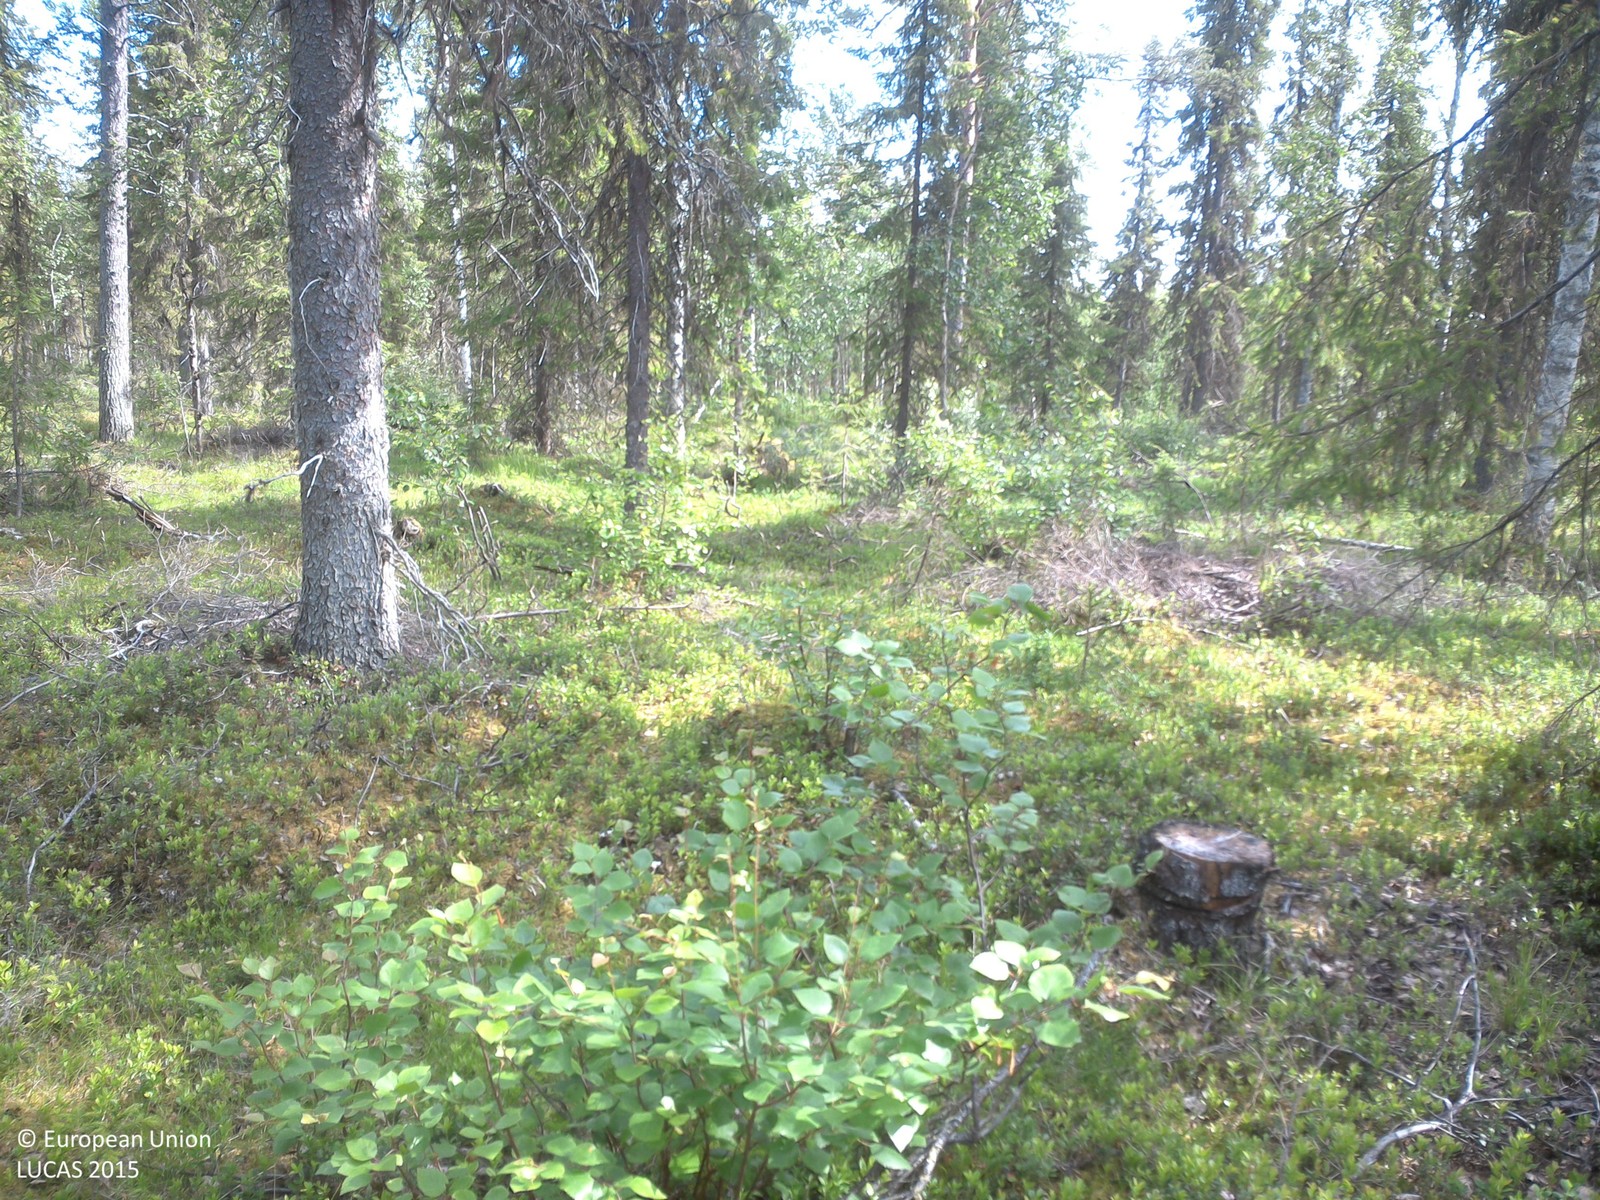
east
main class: Woodland
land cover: Spruce dominated mixed woodland
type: boreal forest
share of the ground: 25 - 50 %
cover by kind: shrubs 45 %, coniferous forest trees 25 %, broadleaved forest trees 10 %, herbaceous plants 10 %, lichens and mosses 10 %
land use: Forestry
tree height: > 5 m
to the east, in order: Spruce dominated mixed woodland; Tracks; Spruce dominated mixed woodland; Shrubland without tree cover; Grassland without tree/shrub cover; Inland fresh running water
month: July
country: SE
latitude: 67.5237
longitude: 23.4459
